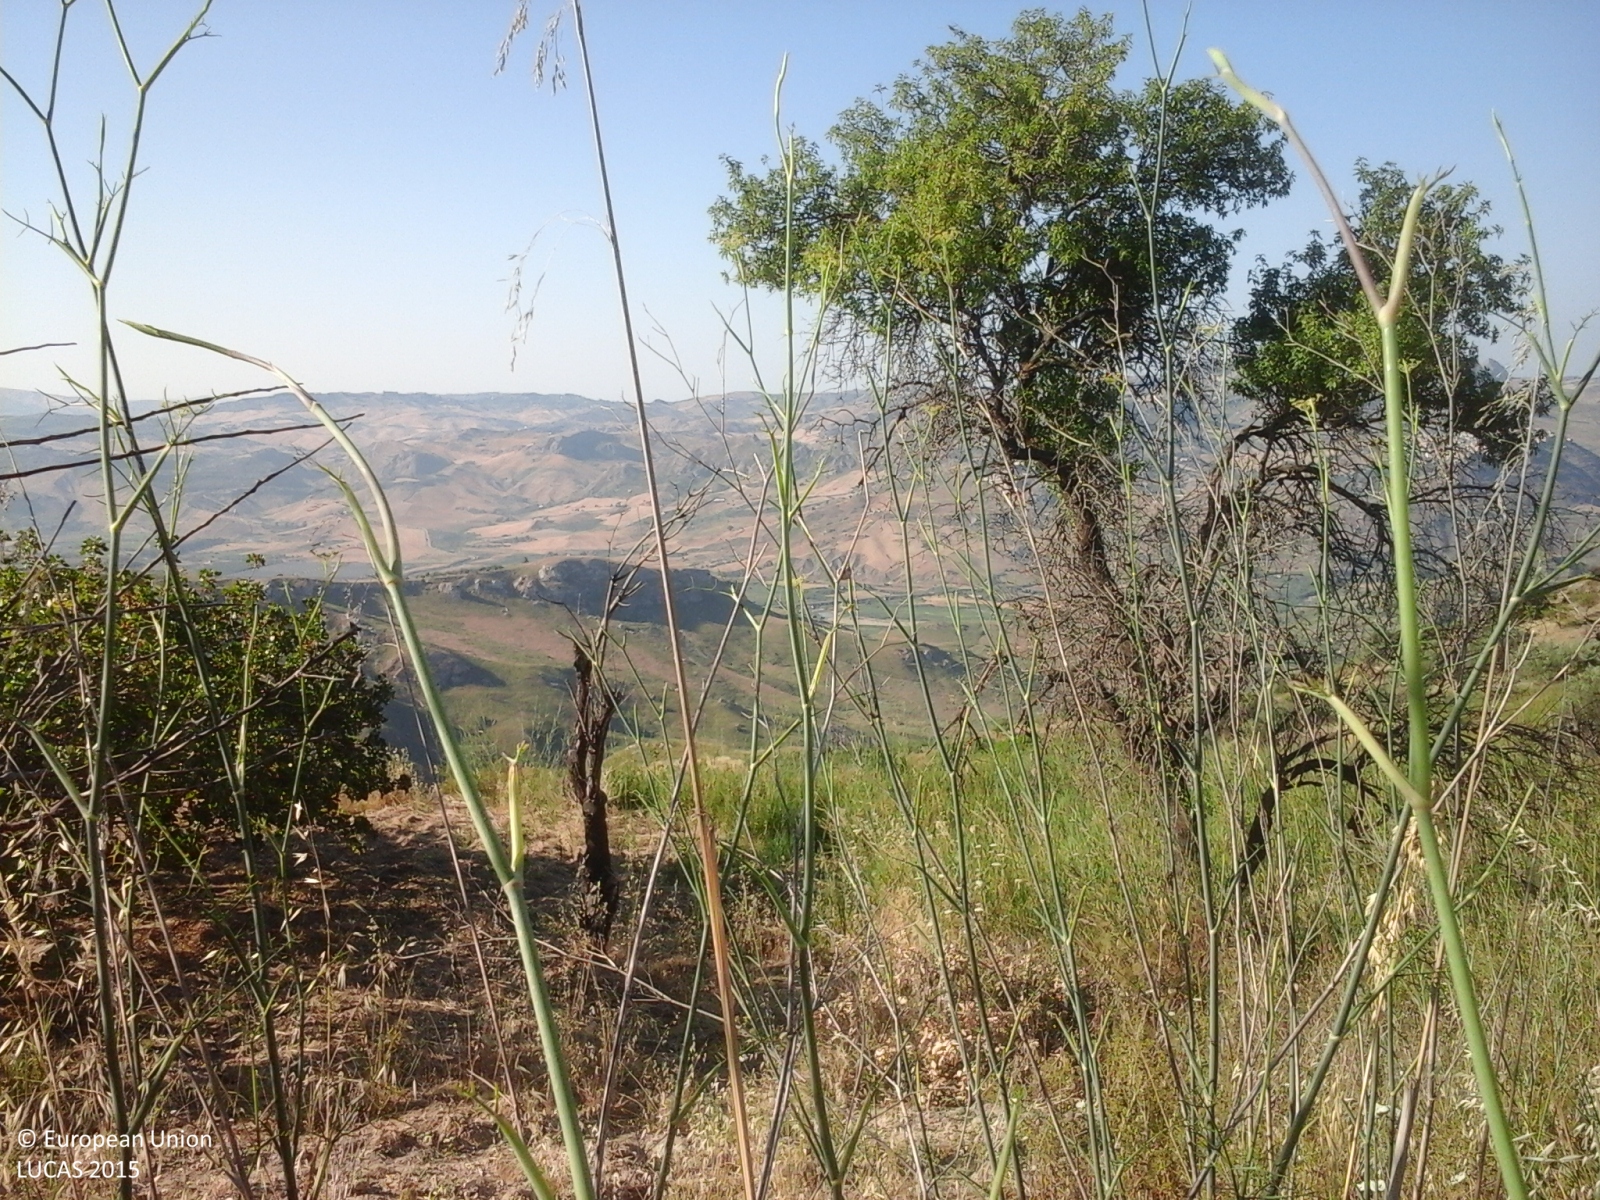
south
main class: Grassland
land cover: Spontaneously vegetated surfaces
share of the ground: > 75 %
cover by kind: herbaceous plants 100 %
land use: Abandoned areas
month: July
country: IT
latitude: 37.5174
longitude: 13.5596
